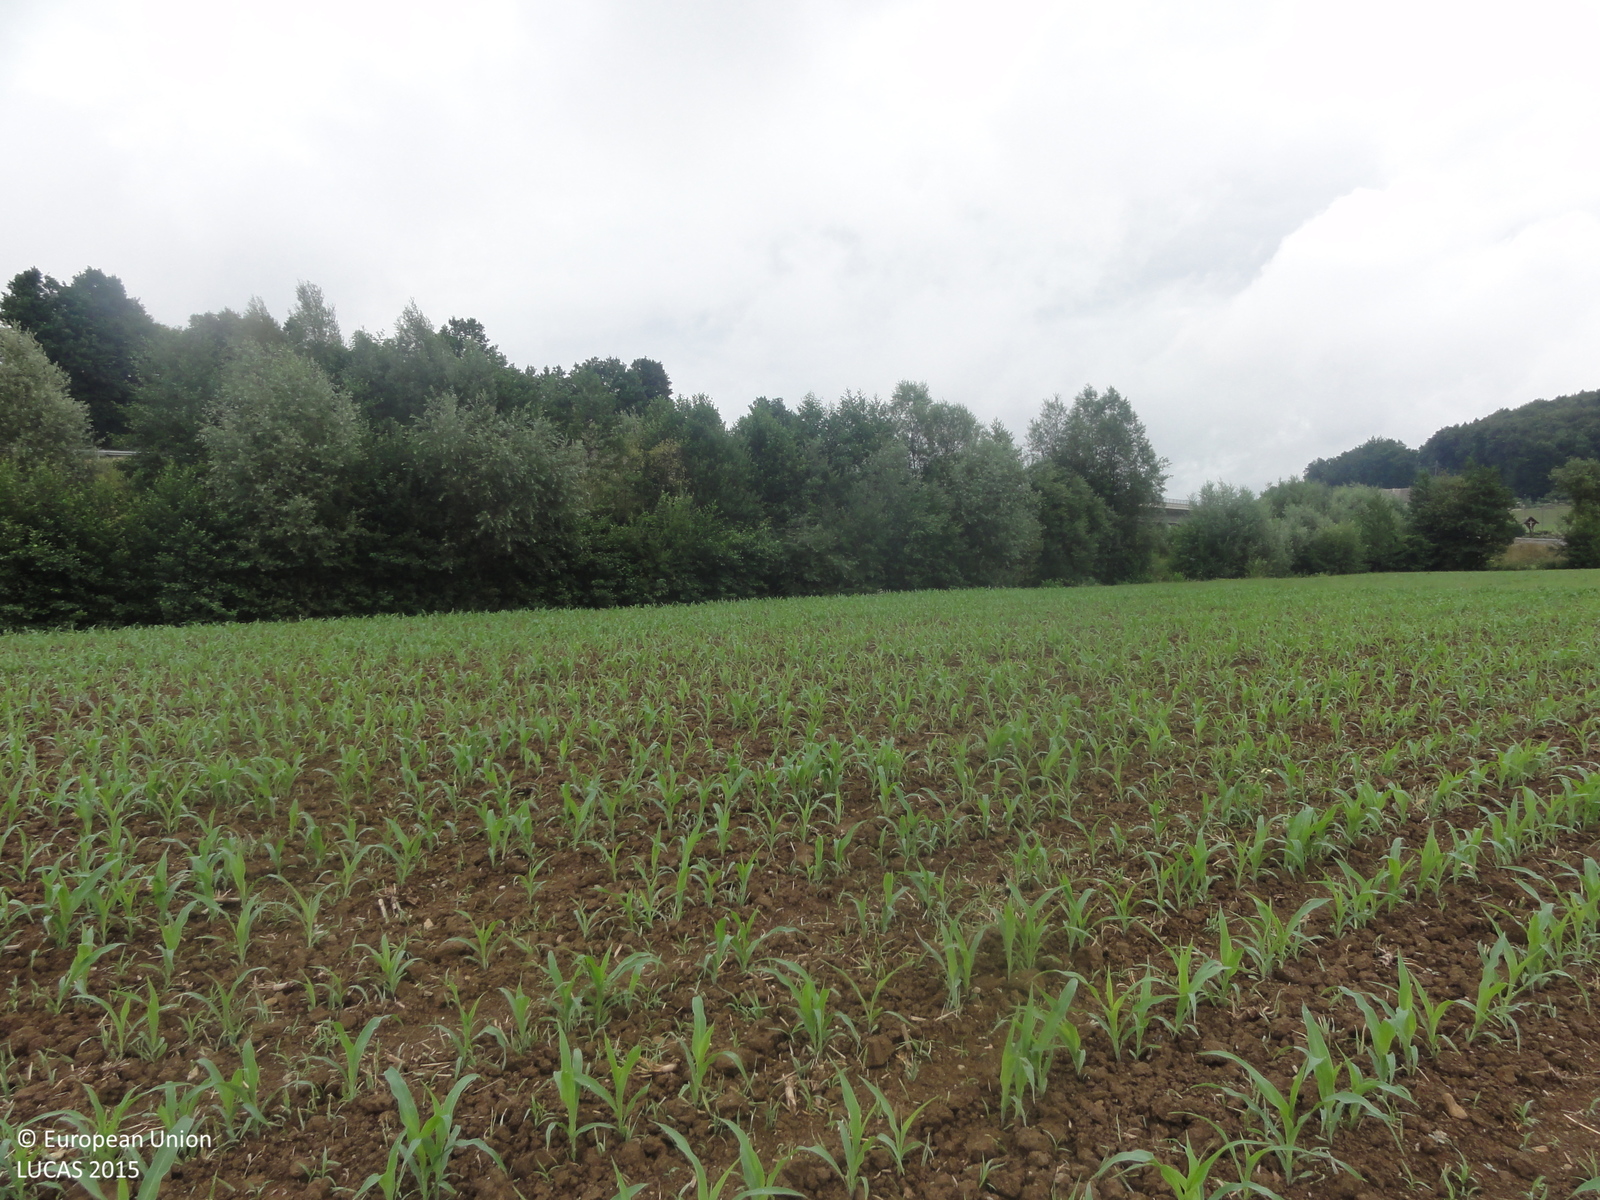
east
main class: Cropland
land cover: Maize
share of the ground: 25 - 50 %
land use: Agriculture (excluding fallow land and kitchen gardens)
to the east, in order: Maize; Grass margins; Abandoned hedges; Rivers and streams; Abandoned hedges; Grass margins; Paved roads, cycling and walking lanes; Grass margins; Ditches and canals; Grass margins; Fences; Shrubland without tree cover; Paved roads, cycling and walking lanes; Grass margins; Paved roads, cycling and walking lanes; Grassland without tree/shrub cover; Fences; Abandoned hedges; Grassland without tree/shrub cover
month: July
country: SI
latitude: 45.9376
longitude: 14.7816
